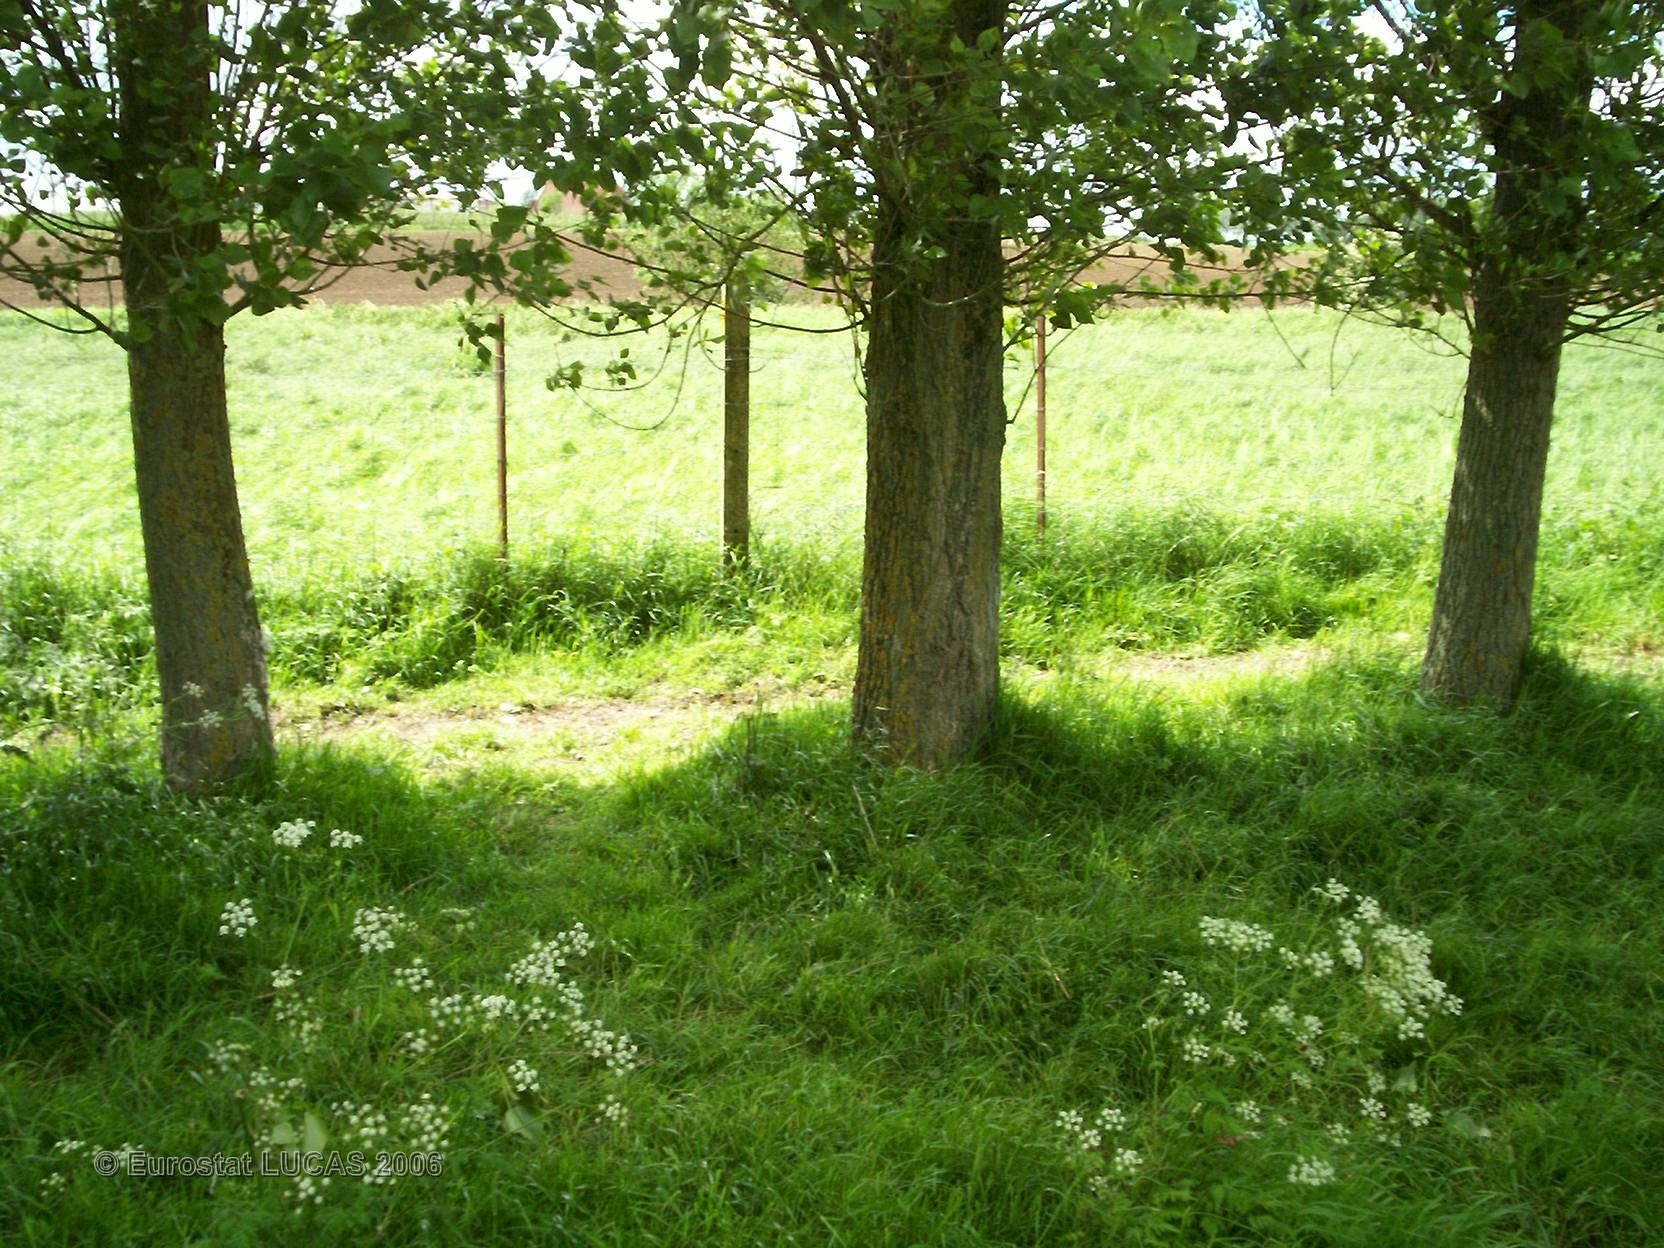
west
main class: Grassland
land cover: Grassland with sparse tree/shrub cover
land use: Agriculture (excluding fallow land and kitchen gardens)
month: May
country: FR
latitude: 50.9117
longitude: 2.4918
